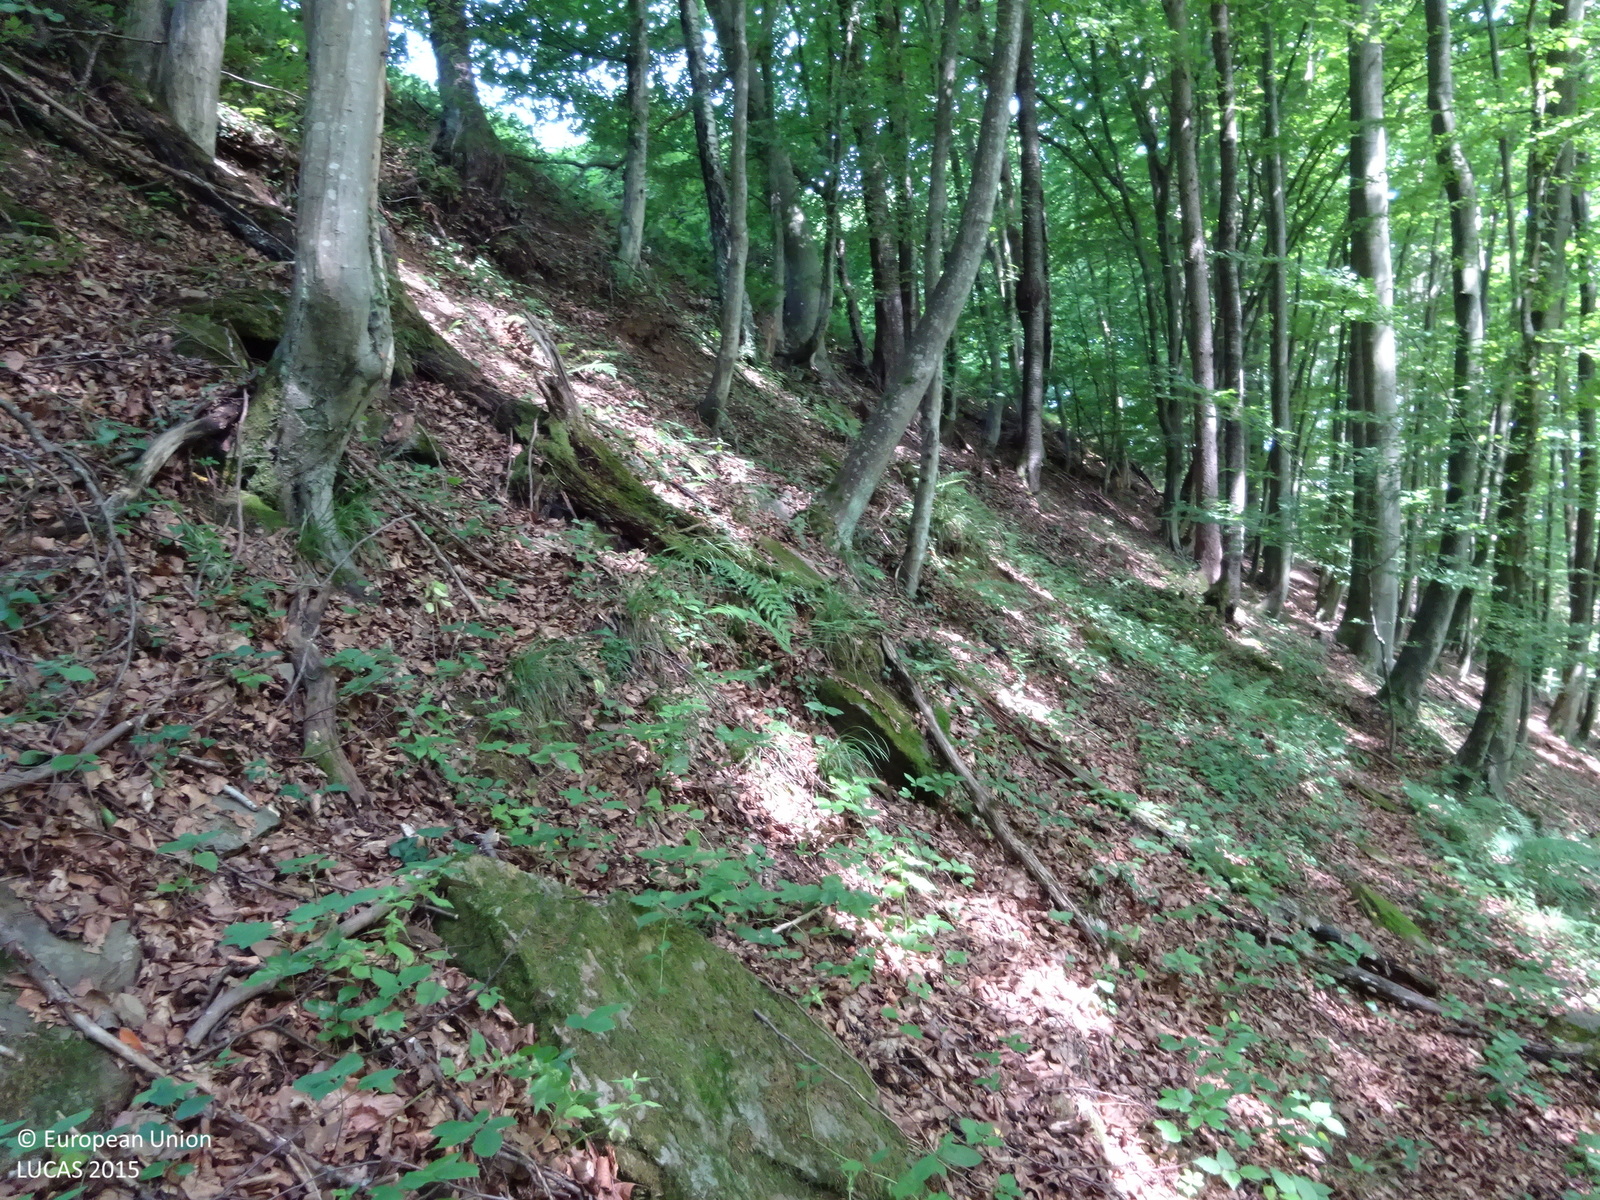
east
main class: Woodland
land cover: Broadleaved woodland
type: mountainous beech forest
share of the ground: > 75 %
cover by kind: broadleaved forest trees 100 %
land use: Forestry
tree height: > 5 m
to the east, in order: Broadleaved woodland; Tracks; Groves; Vineyards; Lines of trees; Tracks; Fences; Lines of trees; Grassland without tree/shrub cover; Broadleaved woodland; Tracks; Broadleaved woodland; Tracks; Rivers and streams; Broadleaved woodland; Tracks; Broadleaved woodland; Pine dominated mixed woodland; Tracks; Grass margins; Vineyards
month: July
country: AT
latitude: 46.7906
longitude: 15.4358
